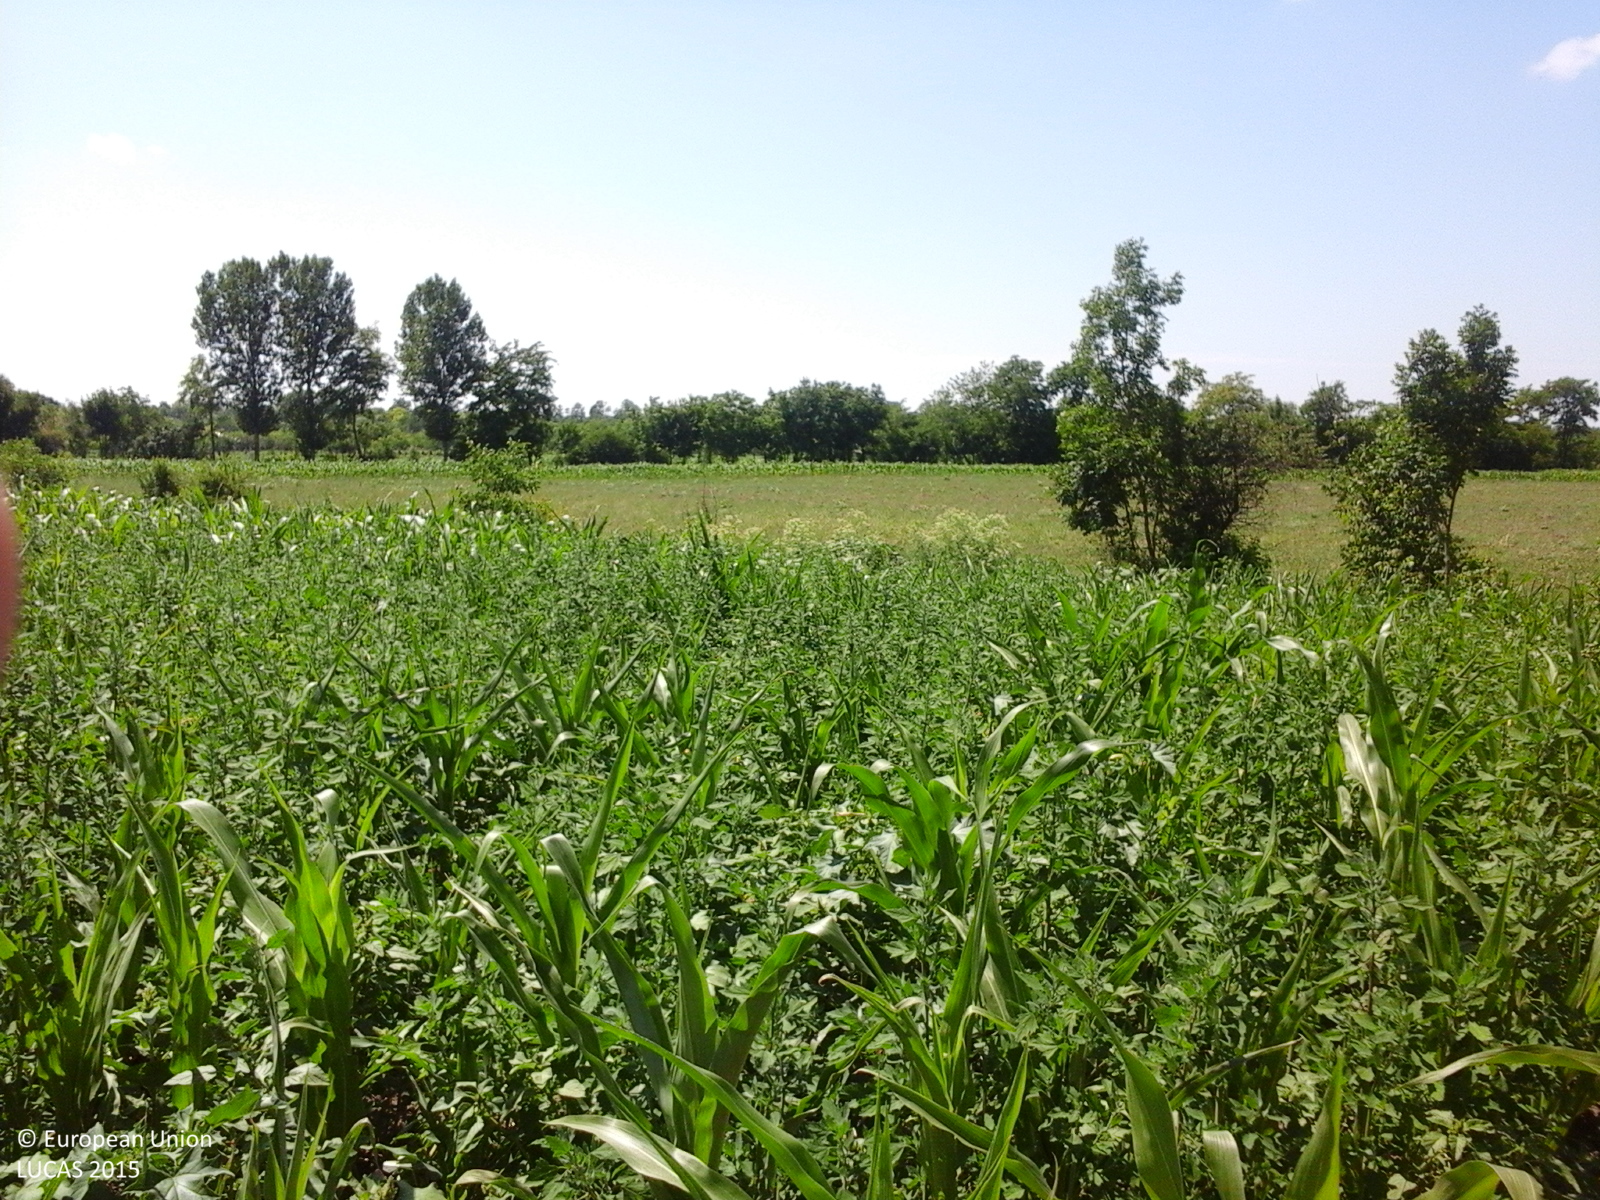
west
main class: Cropland
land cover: Maize
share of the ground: 25 - 50 %
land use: Agriculture (excluding fallow land and kitchen gardens)
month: June
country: RO
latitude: 47.4697
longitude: 27.5123
